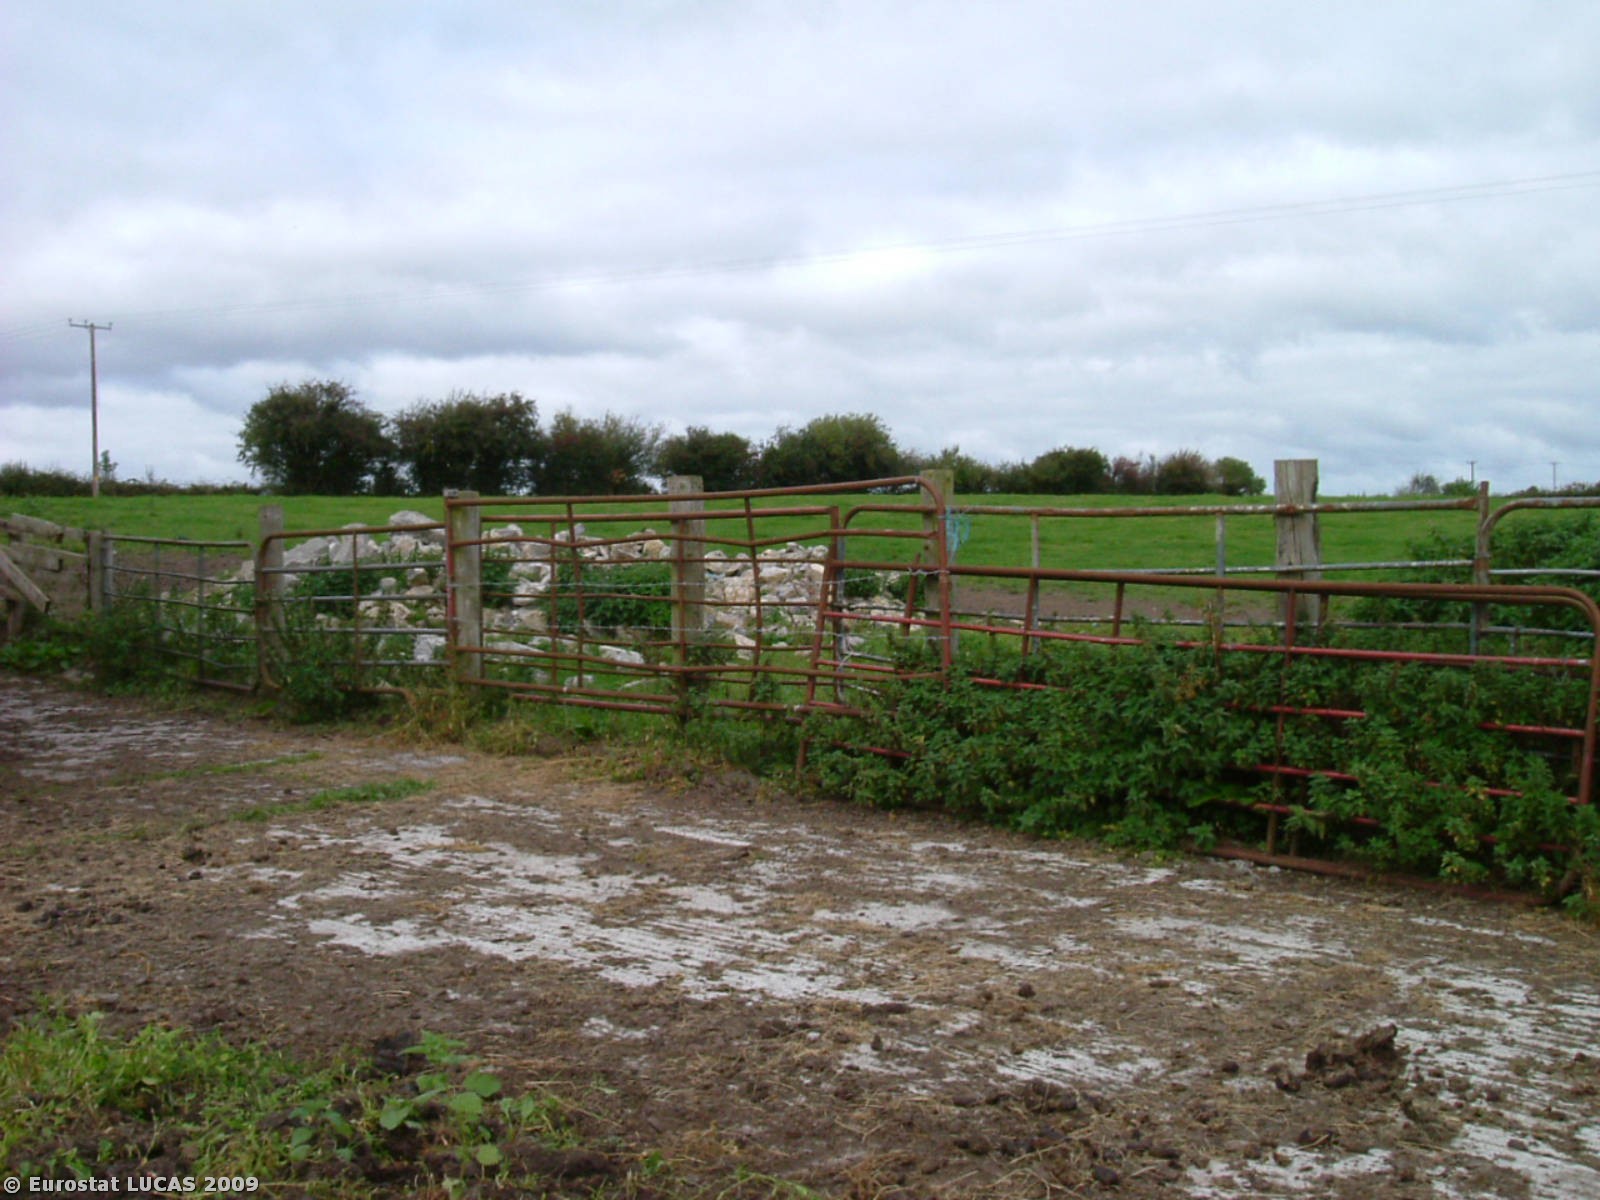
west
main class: Grassland
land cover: Spontaneously vegetated surfaces
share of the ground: > 75 %
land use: Fallow land
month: October
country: IE
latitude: 52.7258
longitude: -7.7121
